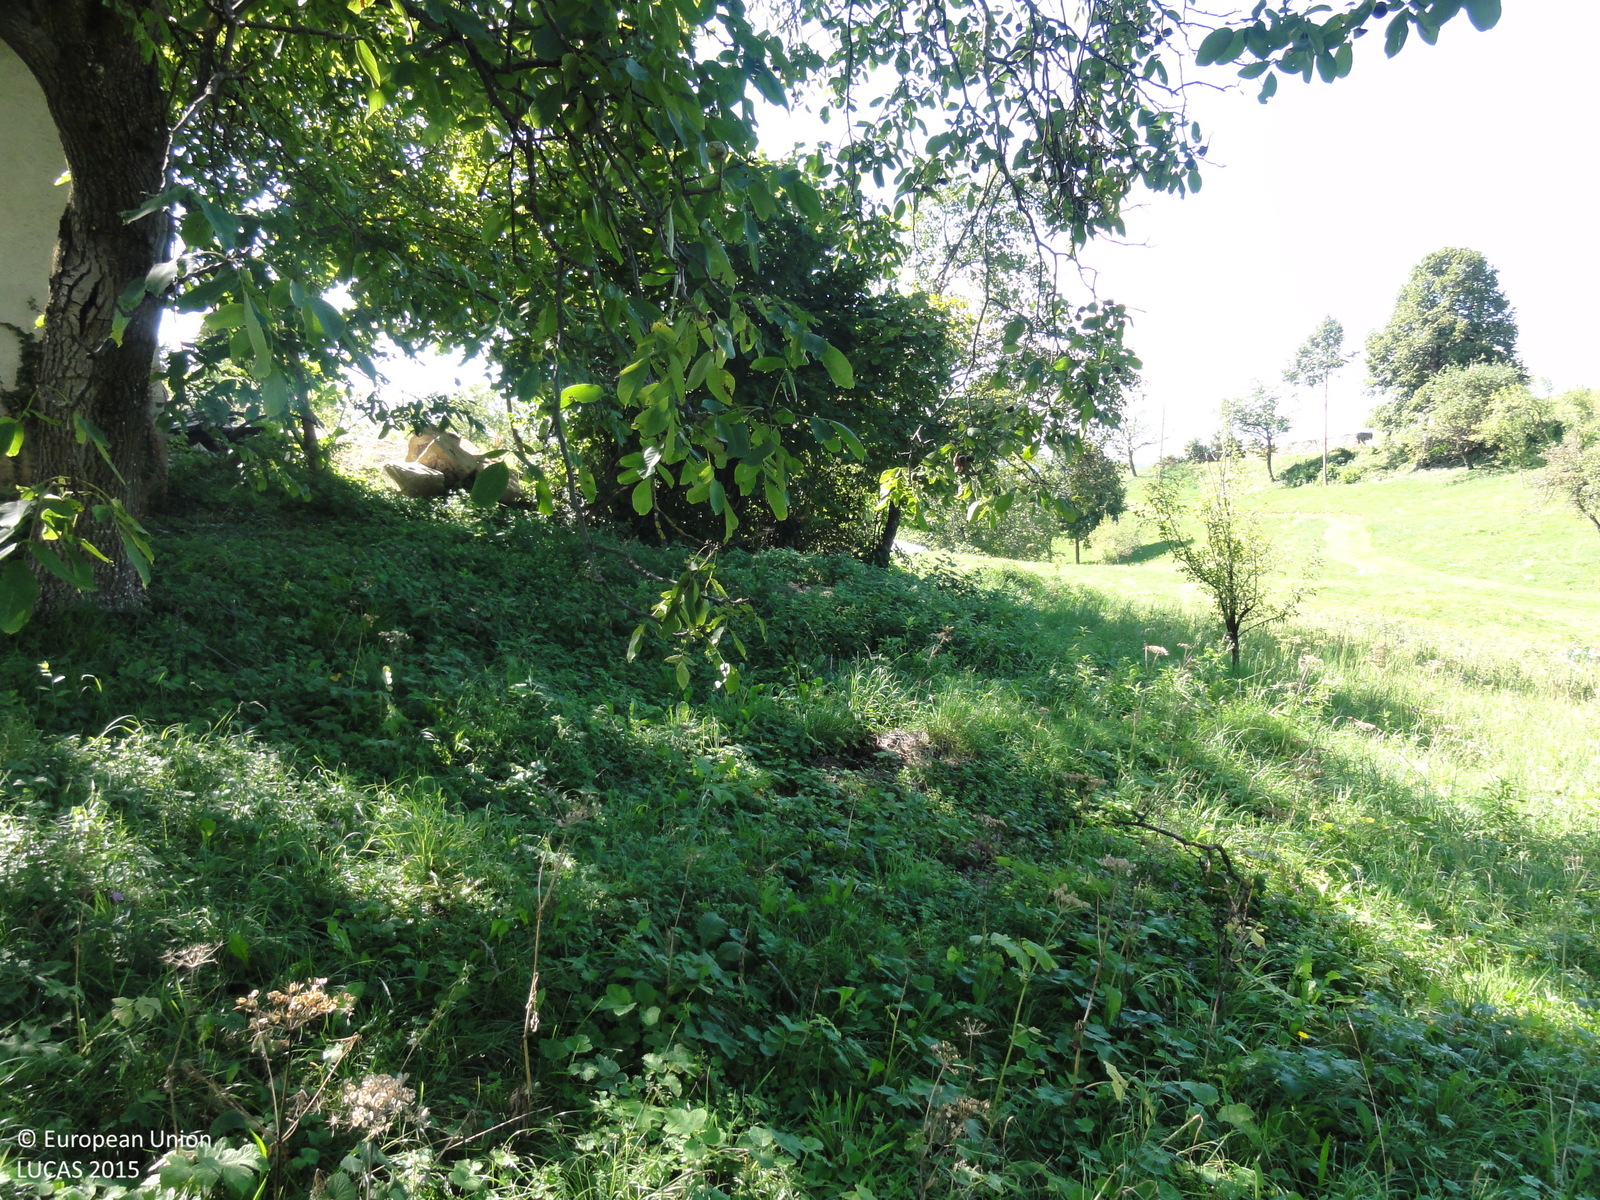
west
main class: Grassland
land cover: Grassland with sparse tree/shrub cover
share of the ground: > 75 %
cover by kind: herbaceous plants 90 %, broadleaved forest trees 5 %, shrubs 5 %
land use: Agriculture (excluding fallow land and kitchen gardens)
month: September
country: SI
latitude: 45.8335
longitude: 15.4426
